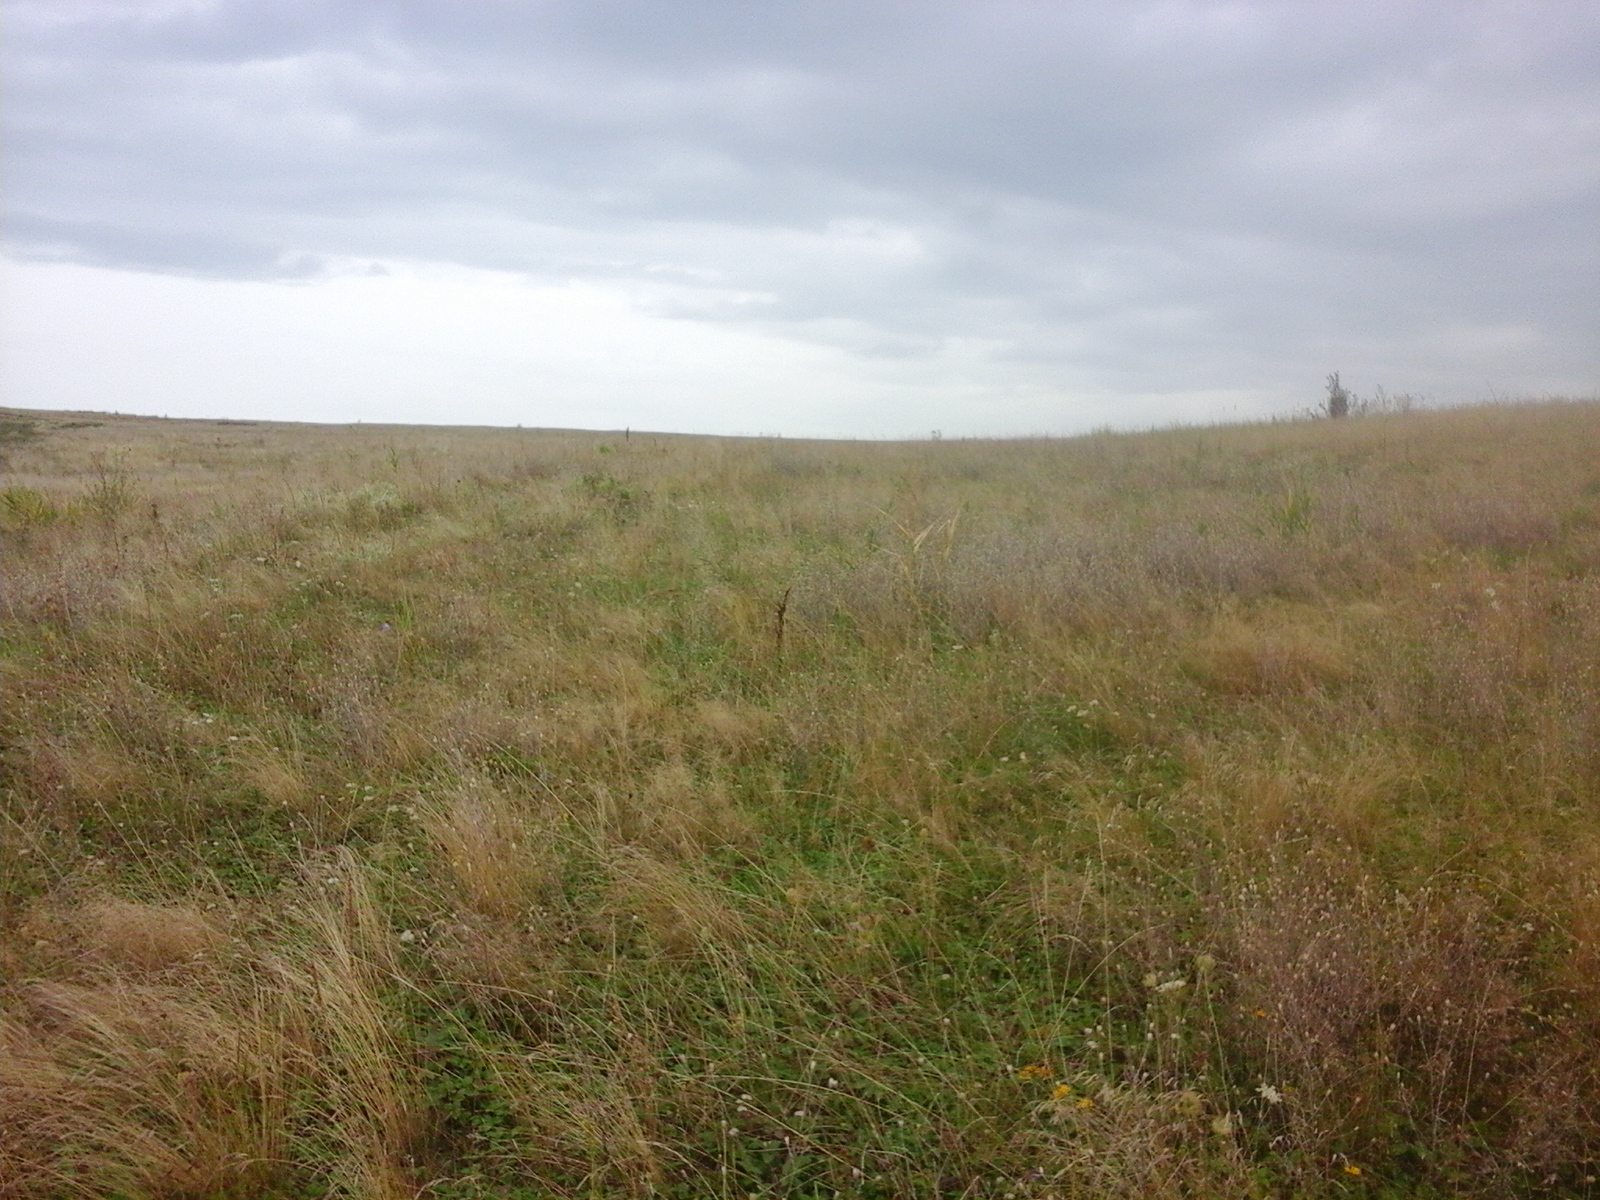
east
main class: Grassland
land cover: Grassland without tree/shrub cover
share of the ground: > 75 %
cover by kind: herbaceous plants 100 %
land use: Agriculture (excluding fallow land and kitchen gardens)
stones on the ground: < 10 %
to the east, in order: Grassland without tree/shrub cover
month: September
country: RO
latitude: 47.2752
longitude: 22.6291
